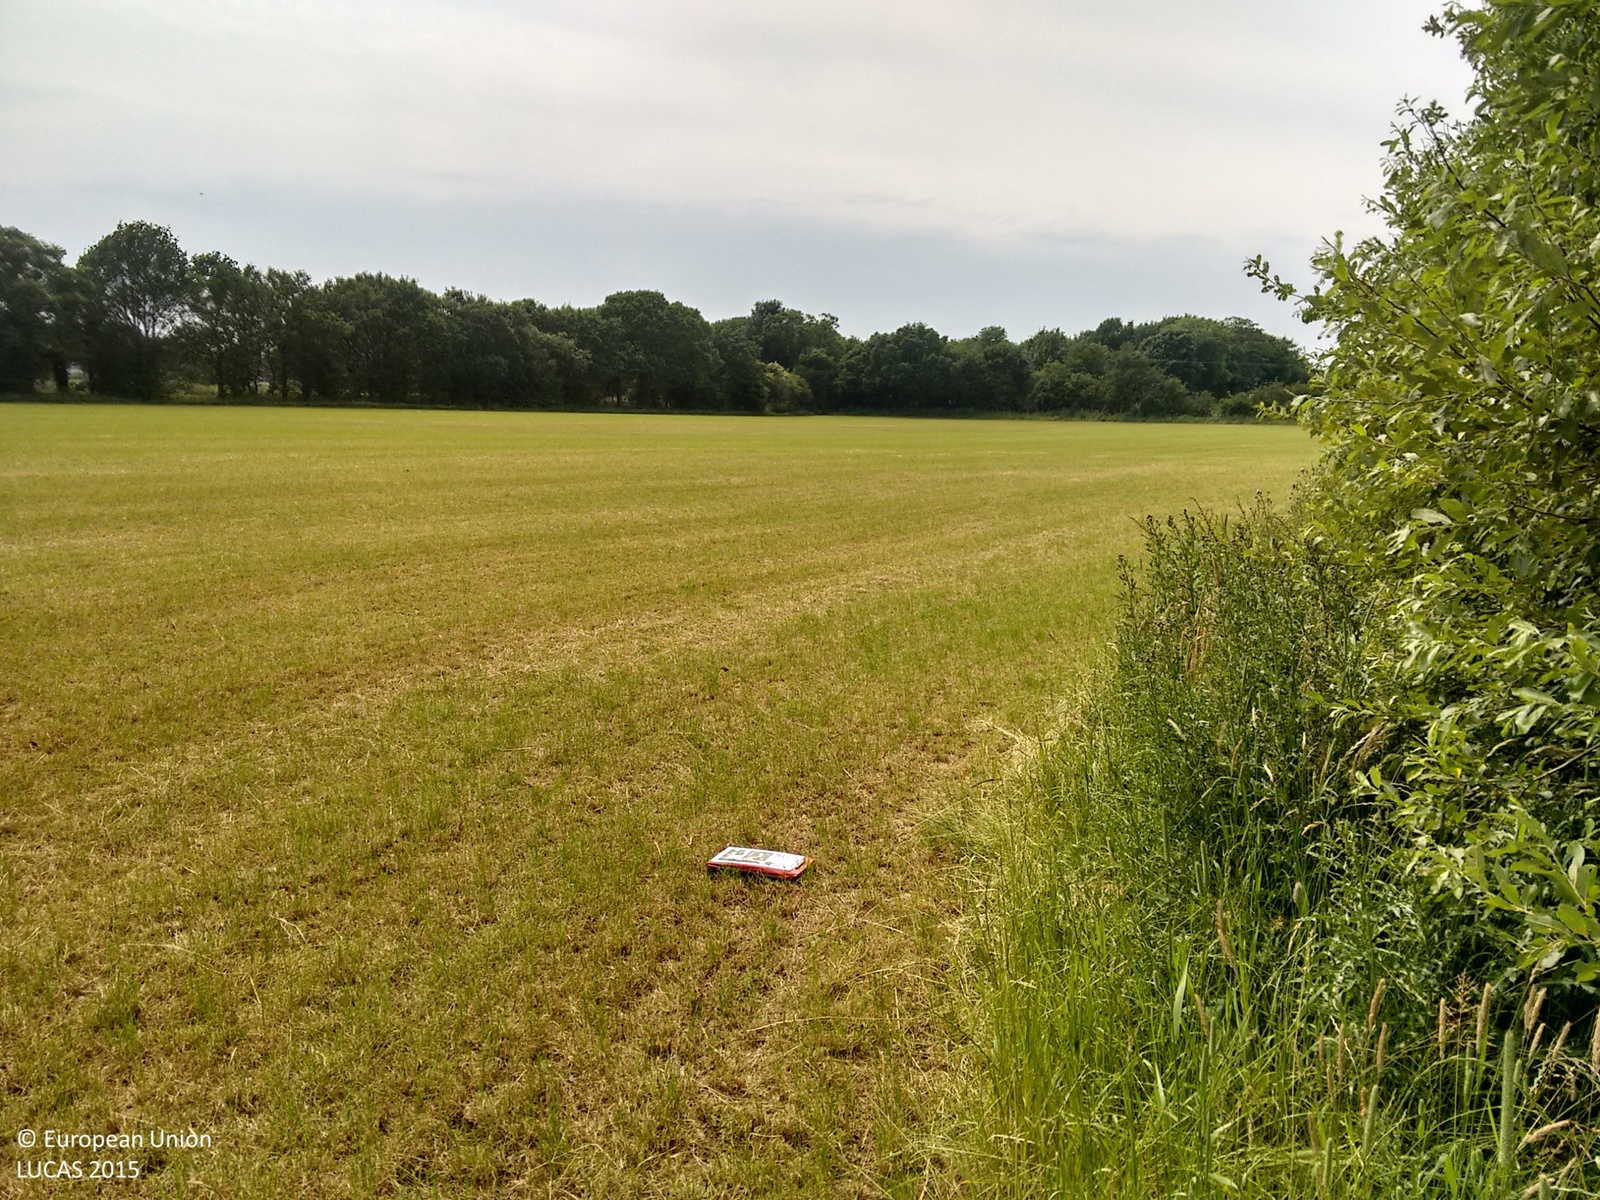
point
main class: Cropland
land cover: Temporary grasslands
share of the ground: > 75 %
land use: Agriculture (excluding fallow land and kitchen gardens)
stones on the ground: < 10 %
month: July
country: GB
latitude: 53.4381
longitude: -2.5457
